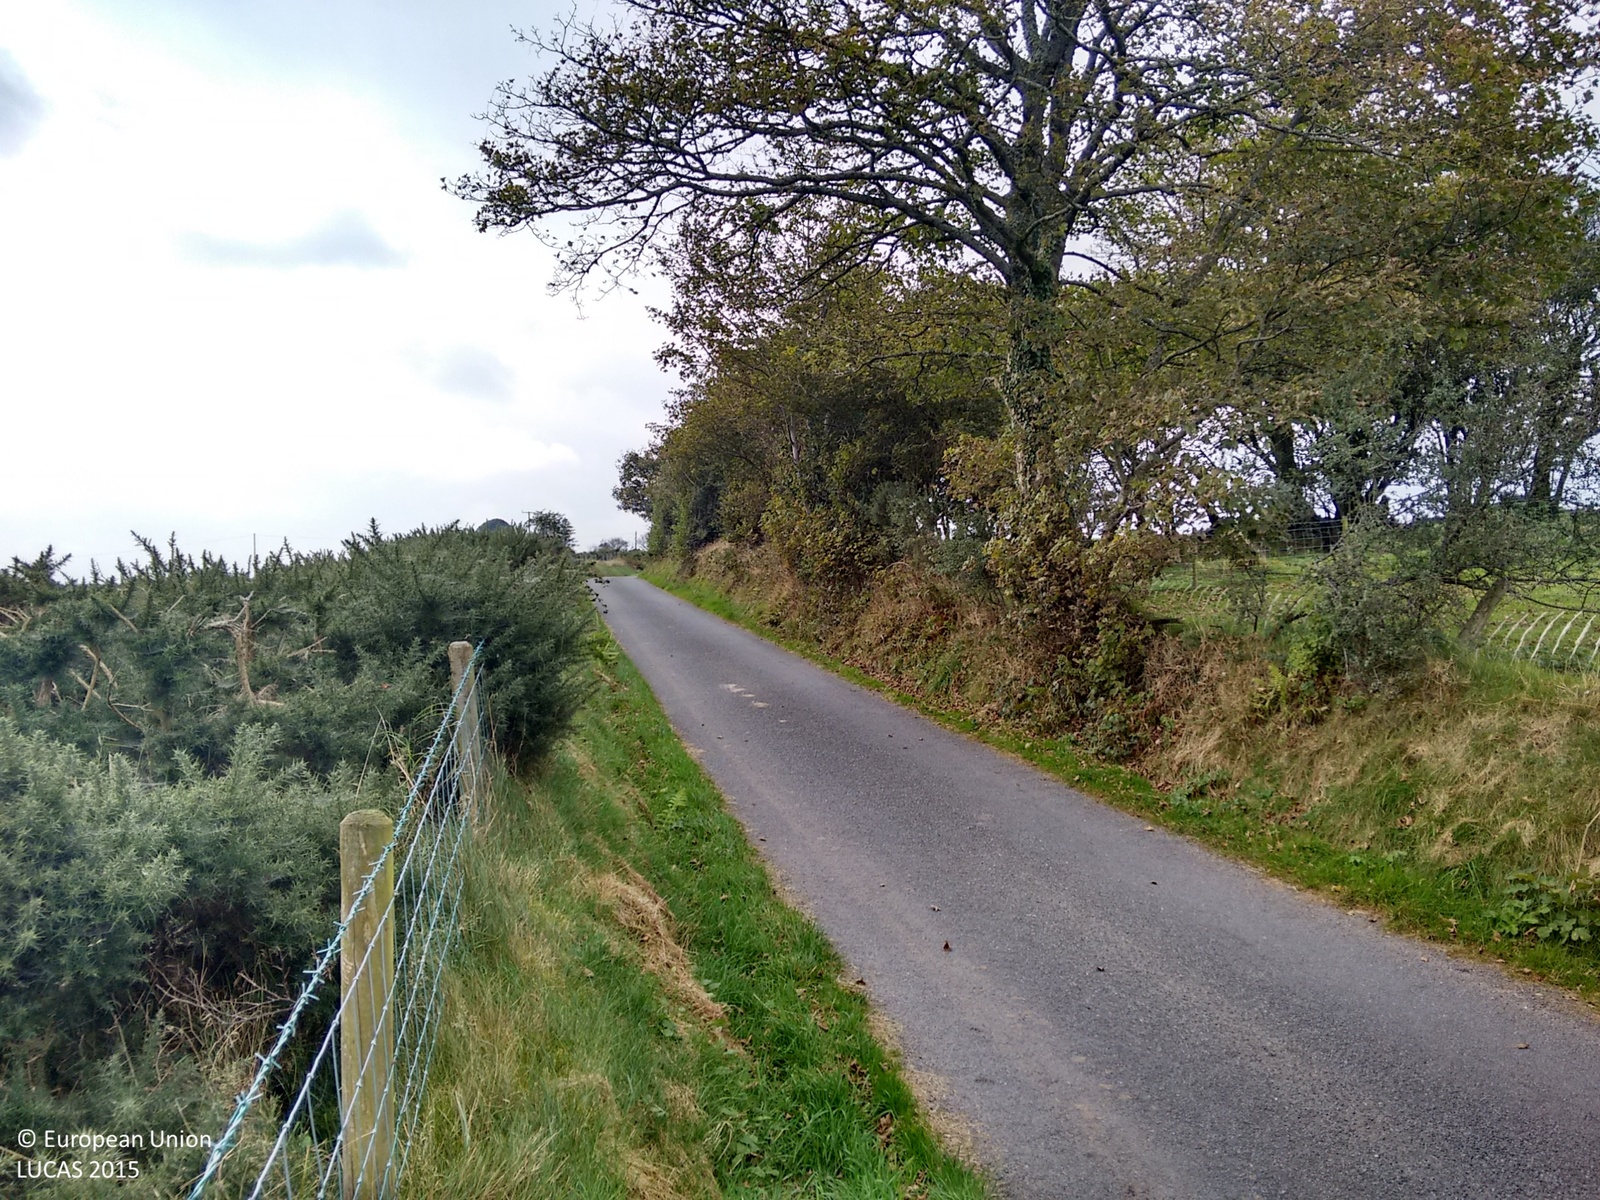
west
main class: Grassland
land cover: Grassland without tree/shrub cover
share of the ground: > 75 %
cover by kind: herbaceous plants 100 %
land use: Agriculture (excluding fallow land and kitchen gardens)
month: October
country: GB
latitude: 52.3003
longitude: -3.9214
